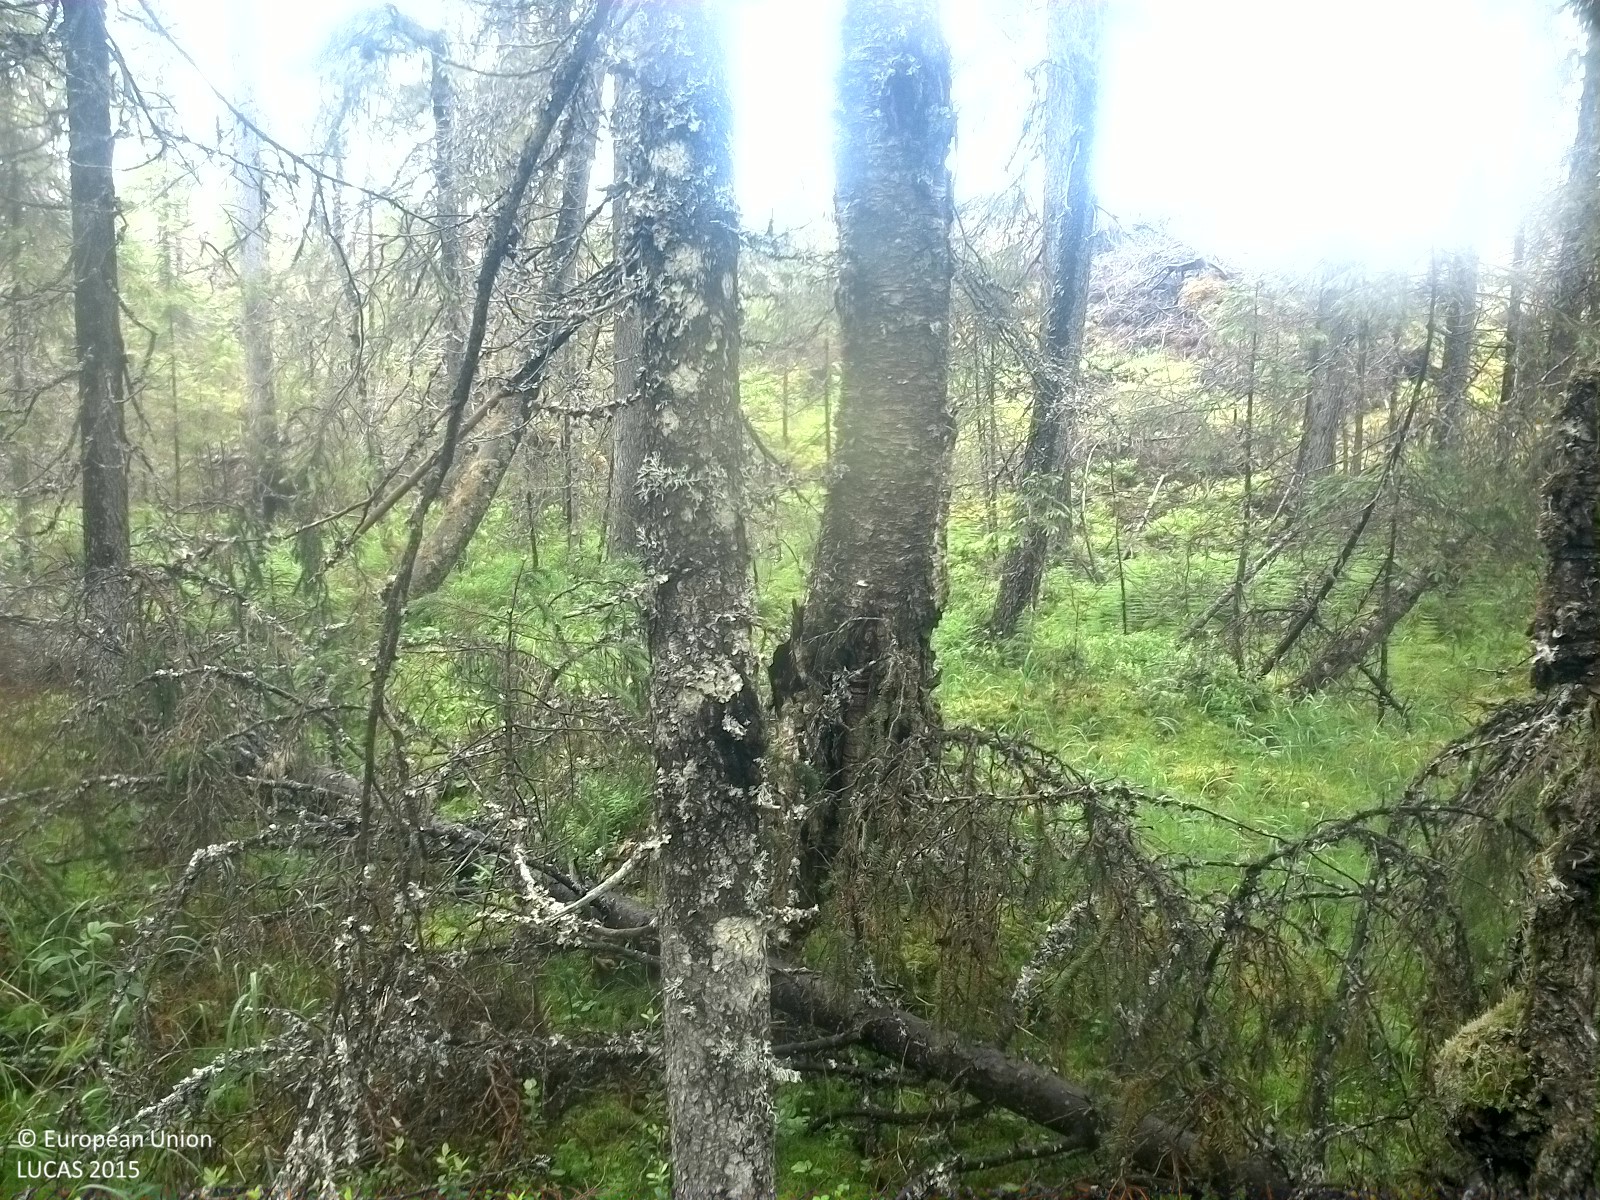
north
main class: Woodland
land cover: Spruce dominated coniferous woodland
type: boreal forest
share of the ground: 25 - 50 %
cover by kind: coniferous forest trees 40 %, lichens and mosses 40 %, herbaceous plants 15 %, broadleaved forest trees 5 %
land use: Forestry
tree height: > 5 m
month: July
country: SE
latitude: 62.4560
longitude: 16.8609
